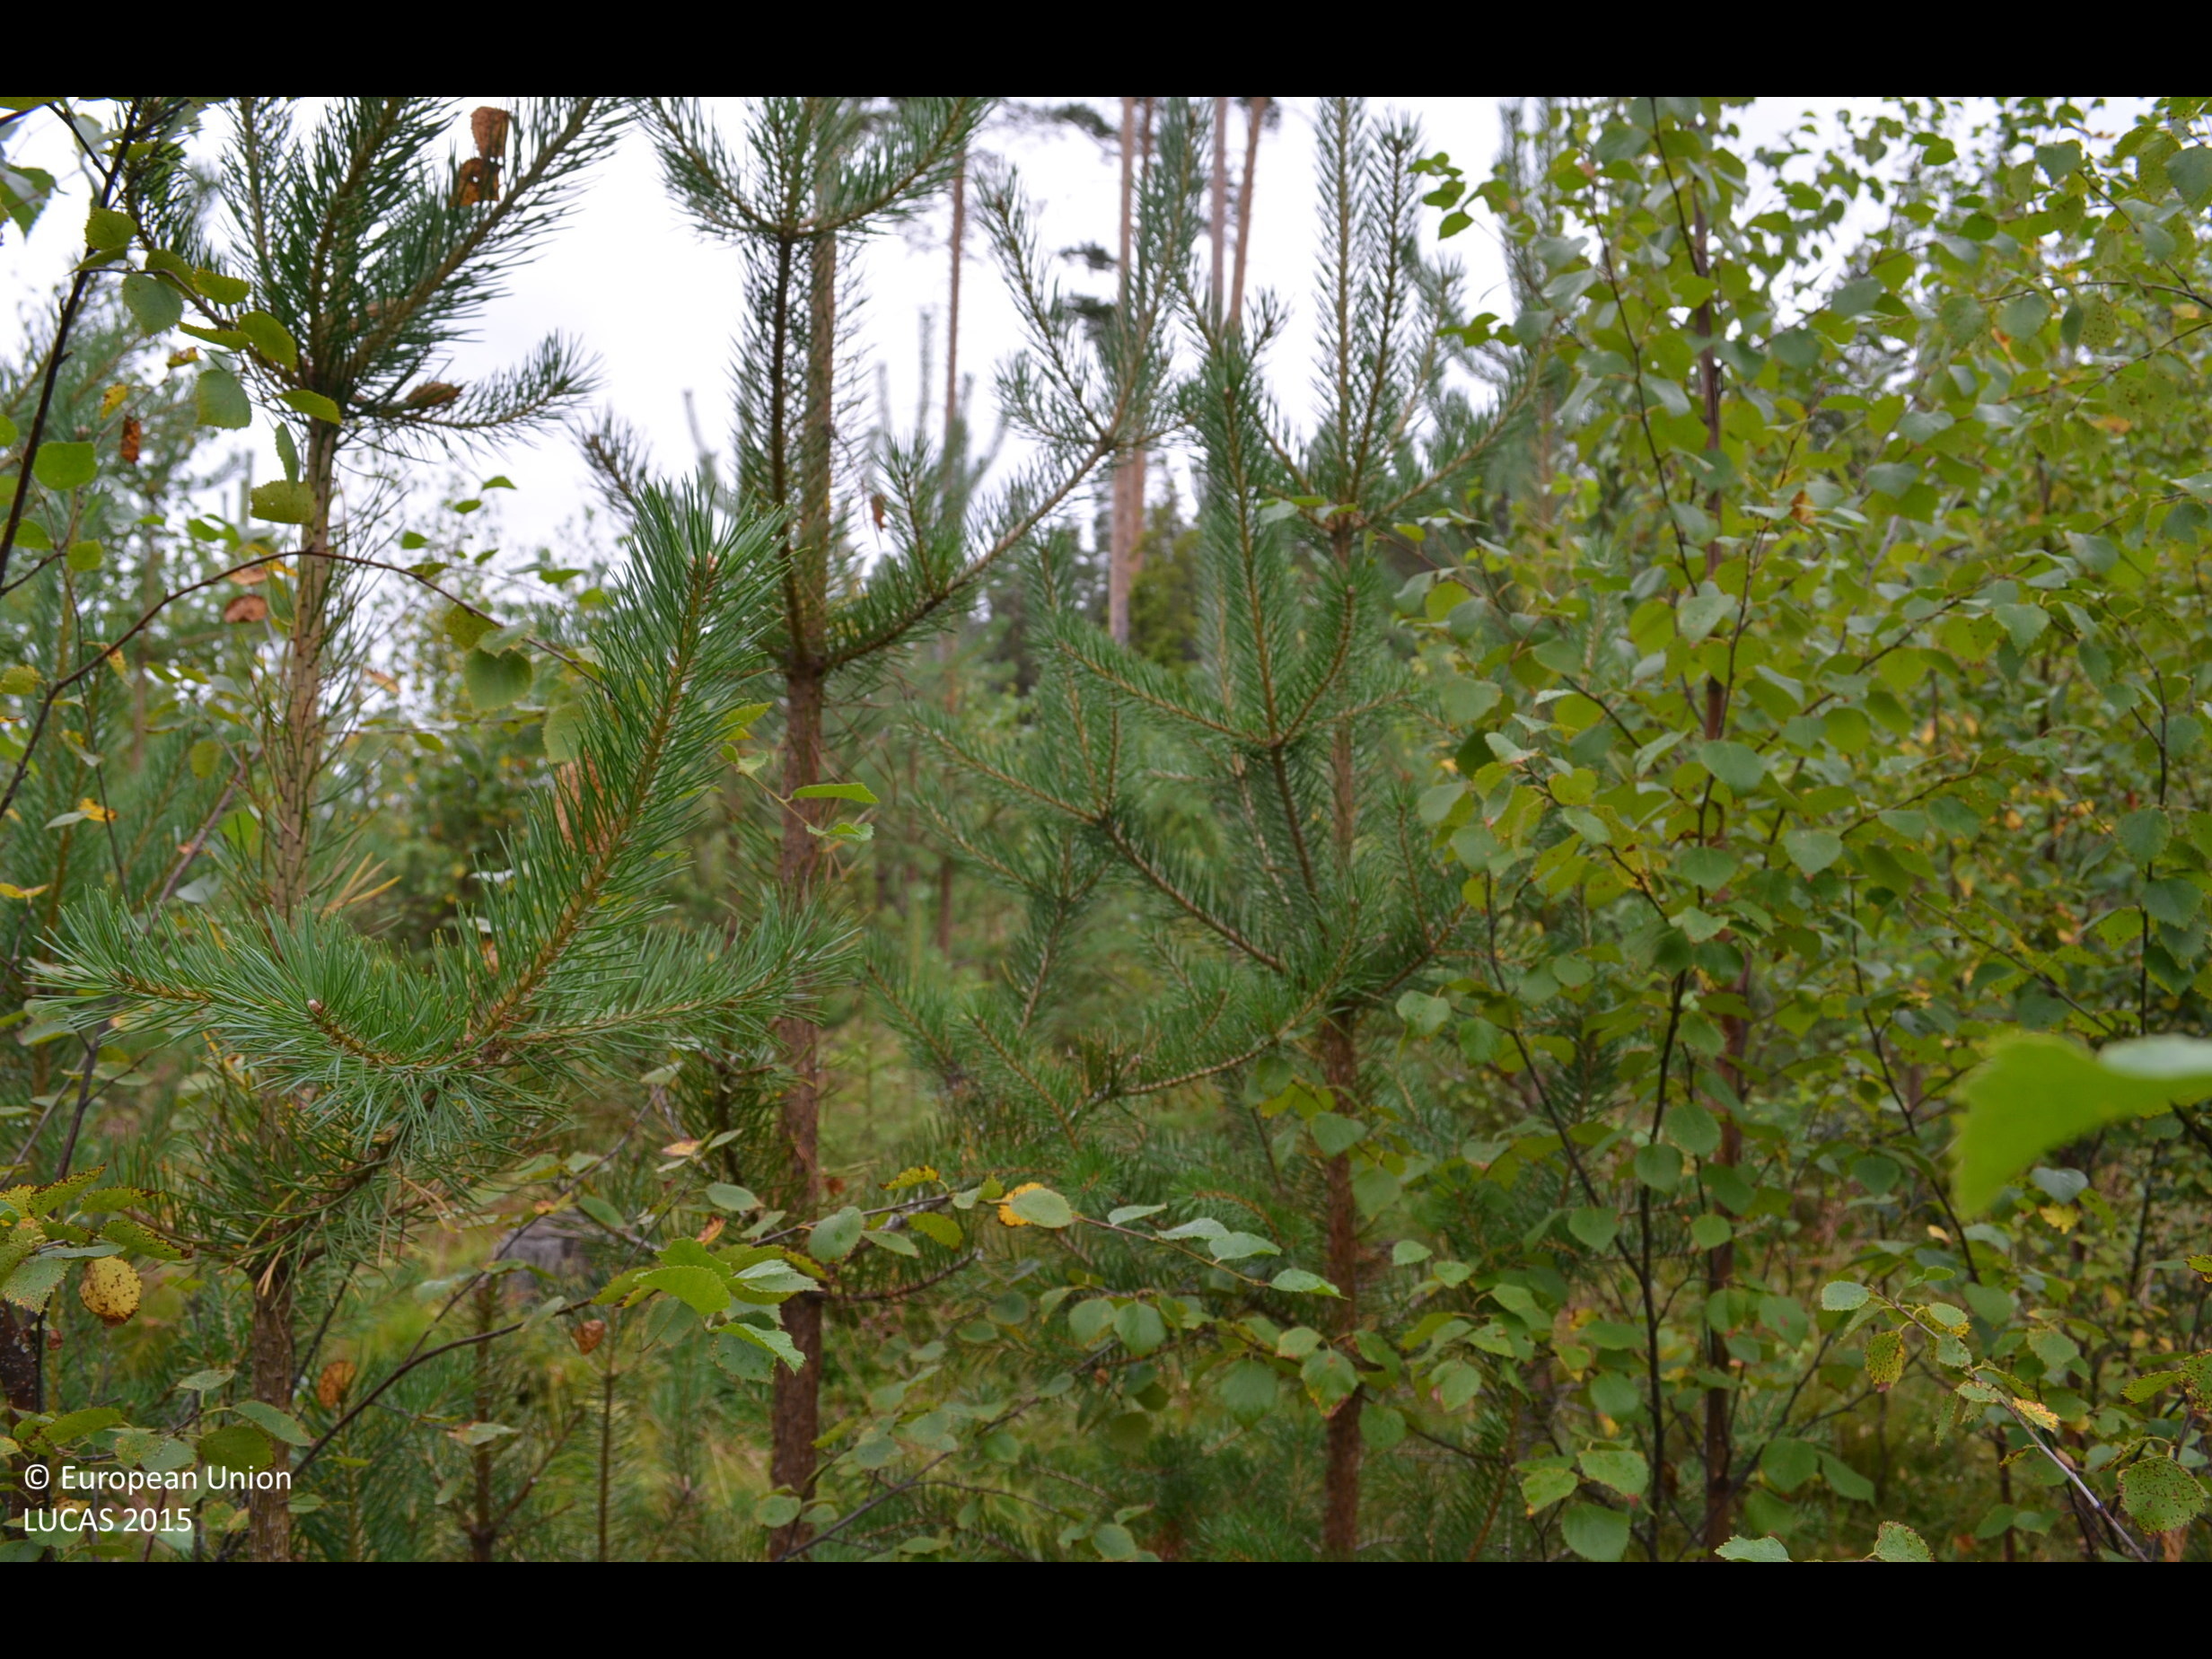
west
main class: Woodland
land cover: Pine dominated mixed woodland
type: boreal forest
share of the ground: > 75 %
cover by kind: coniferous forest trees 50 %, broadleaved forest trees 30 %, shrubs 20 %
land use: Forestry
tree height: < 5 m
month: August
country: FI
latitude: 62.1874
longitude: 24.2466
